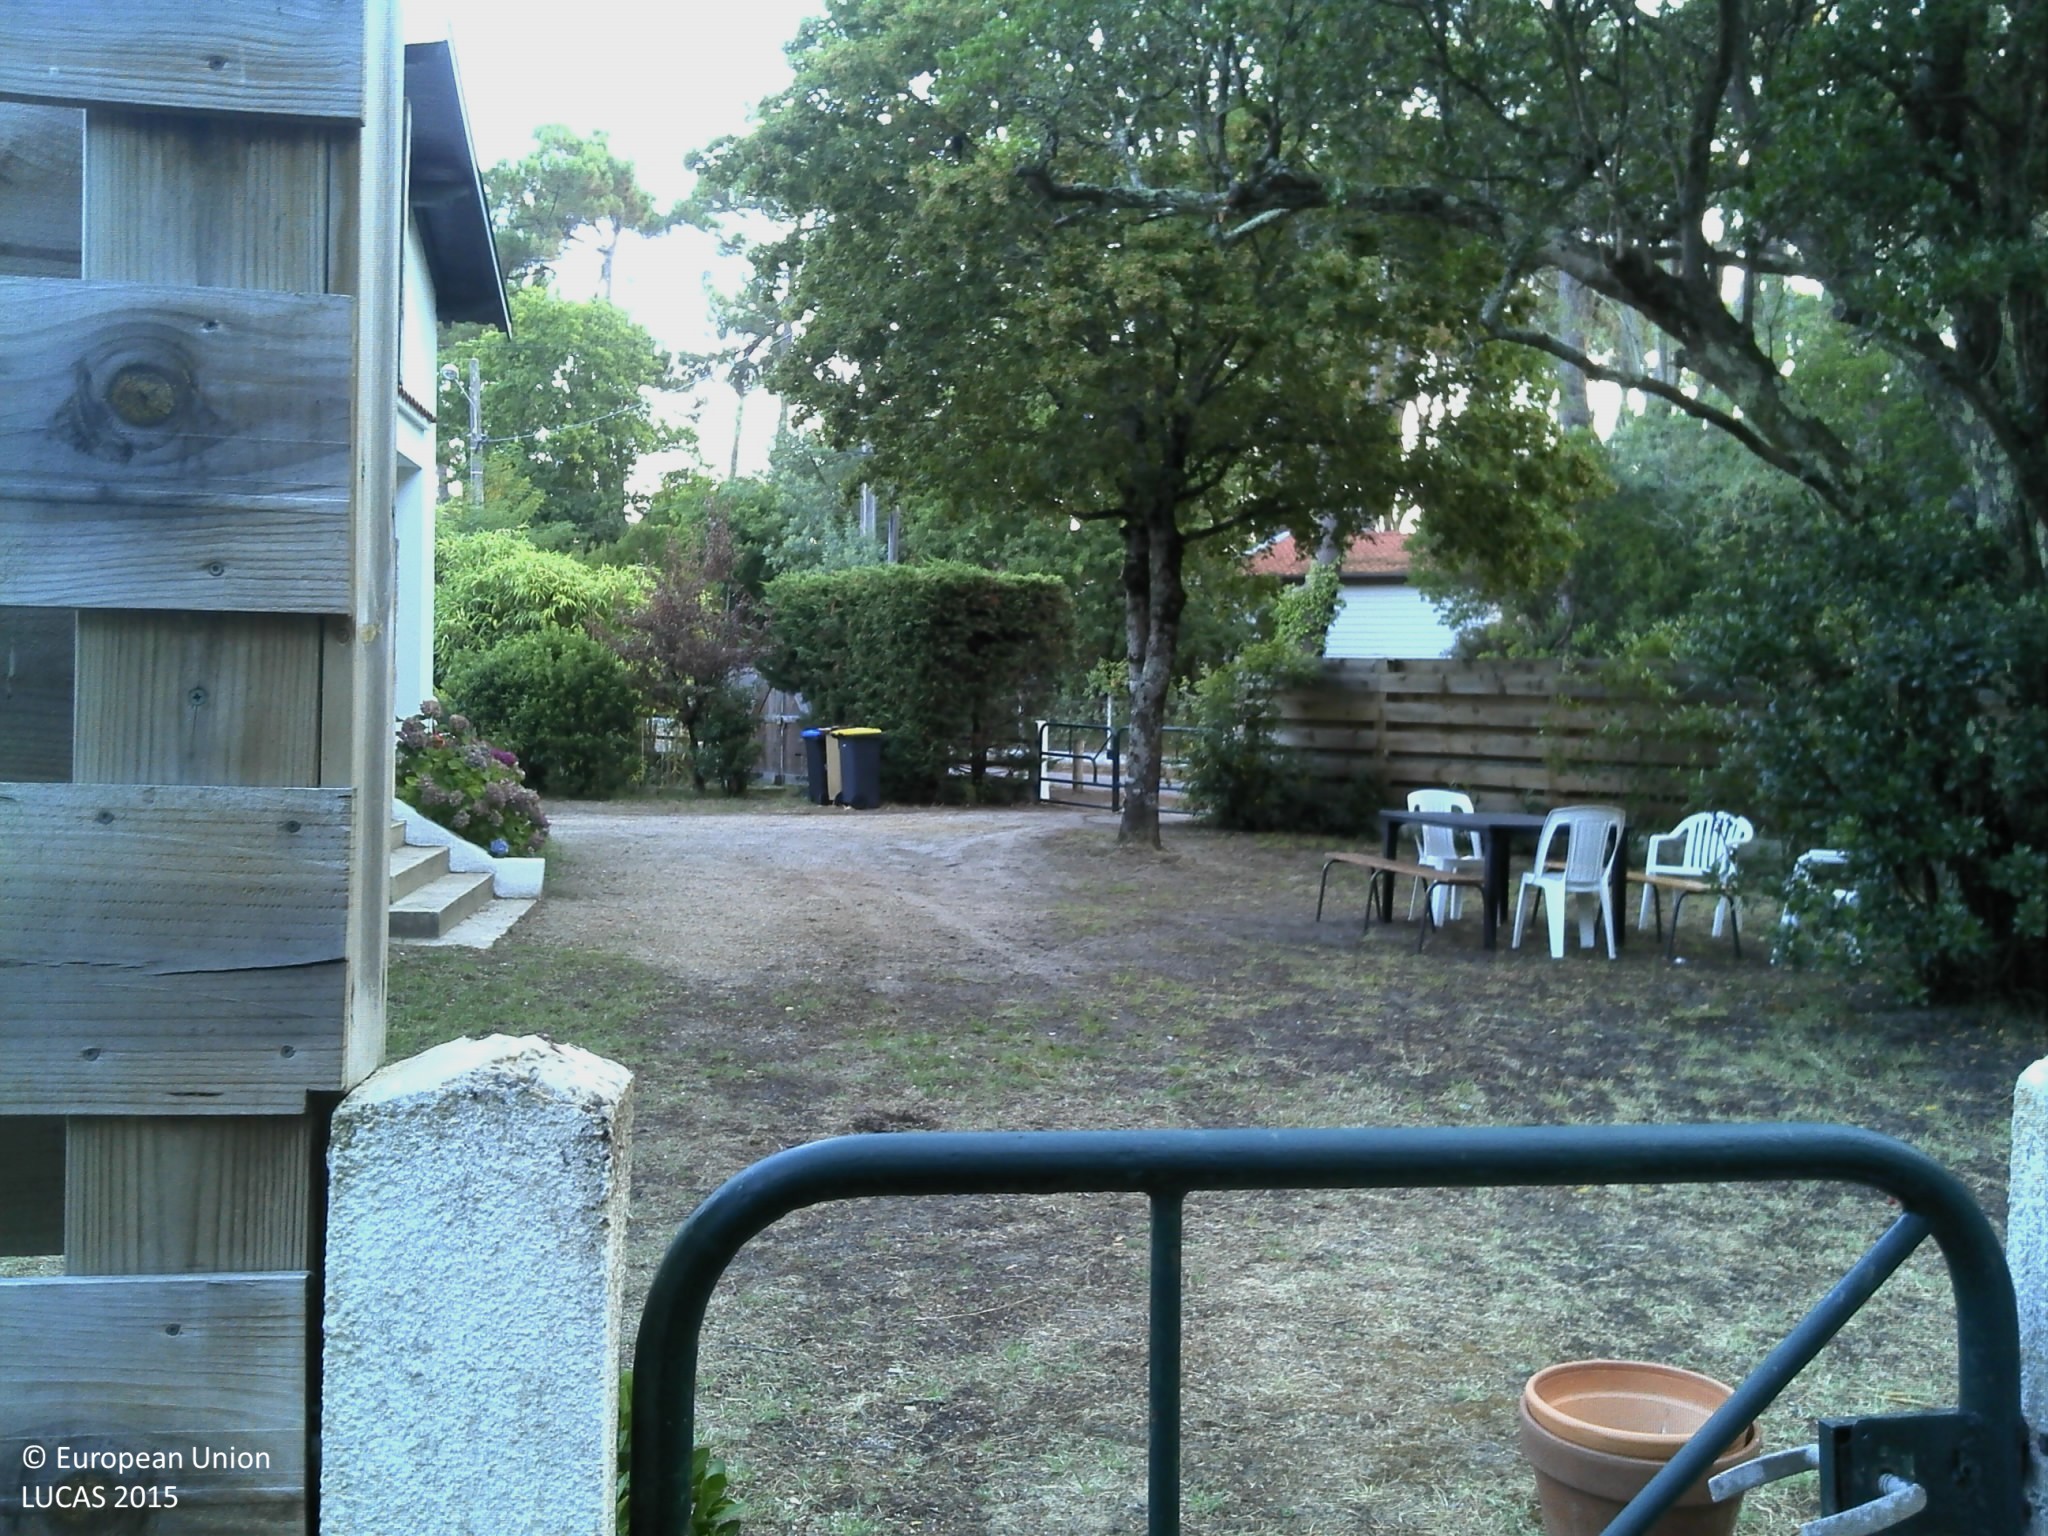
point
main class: Grassland
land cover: Grassland with sparse tree/shrub cover
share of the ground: > 75 %
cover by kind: herbaceous plants 90 %, broadleaved forest trees 5 %, shrubs 5 %
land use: Residential
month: August
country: FR
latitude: 44.7454
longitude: -1.1763
